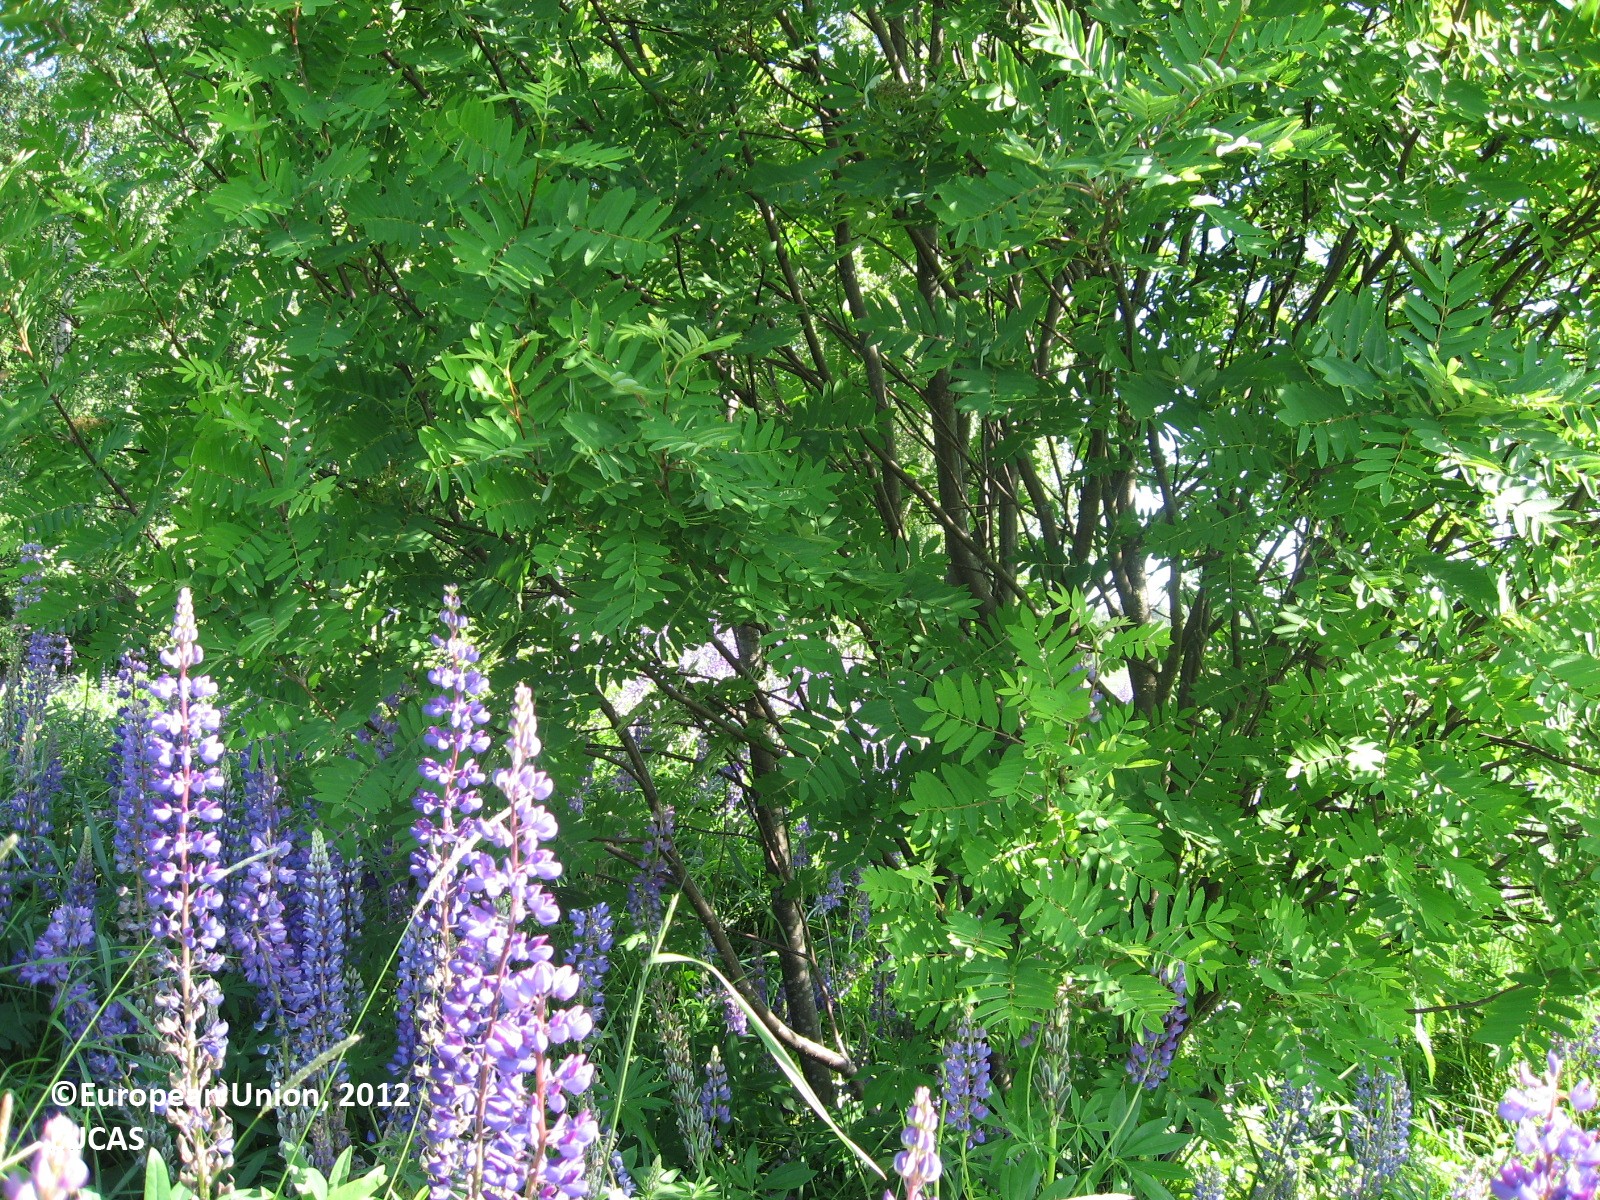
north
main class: Grassland
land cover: Spontaneously vegetated surfaces
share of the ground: > 75 %
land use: Semi-natural and natural areas not in use
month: June
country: FI
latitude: 60.4301
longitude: 26.2262
